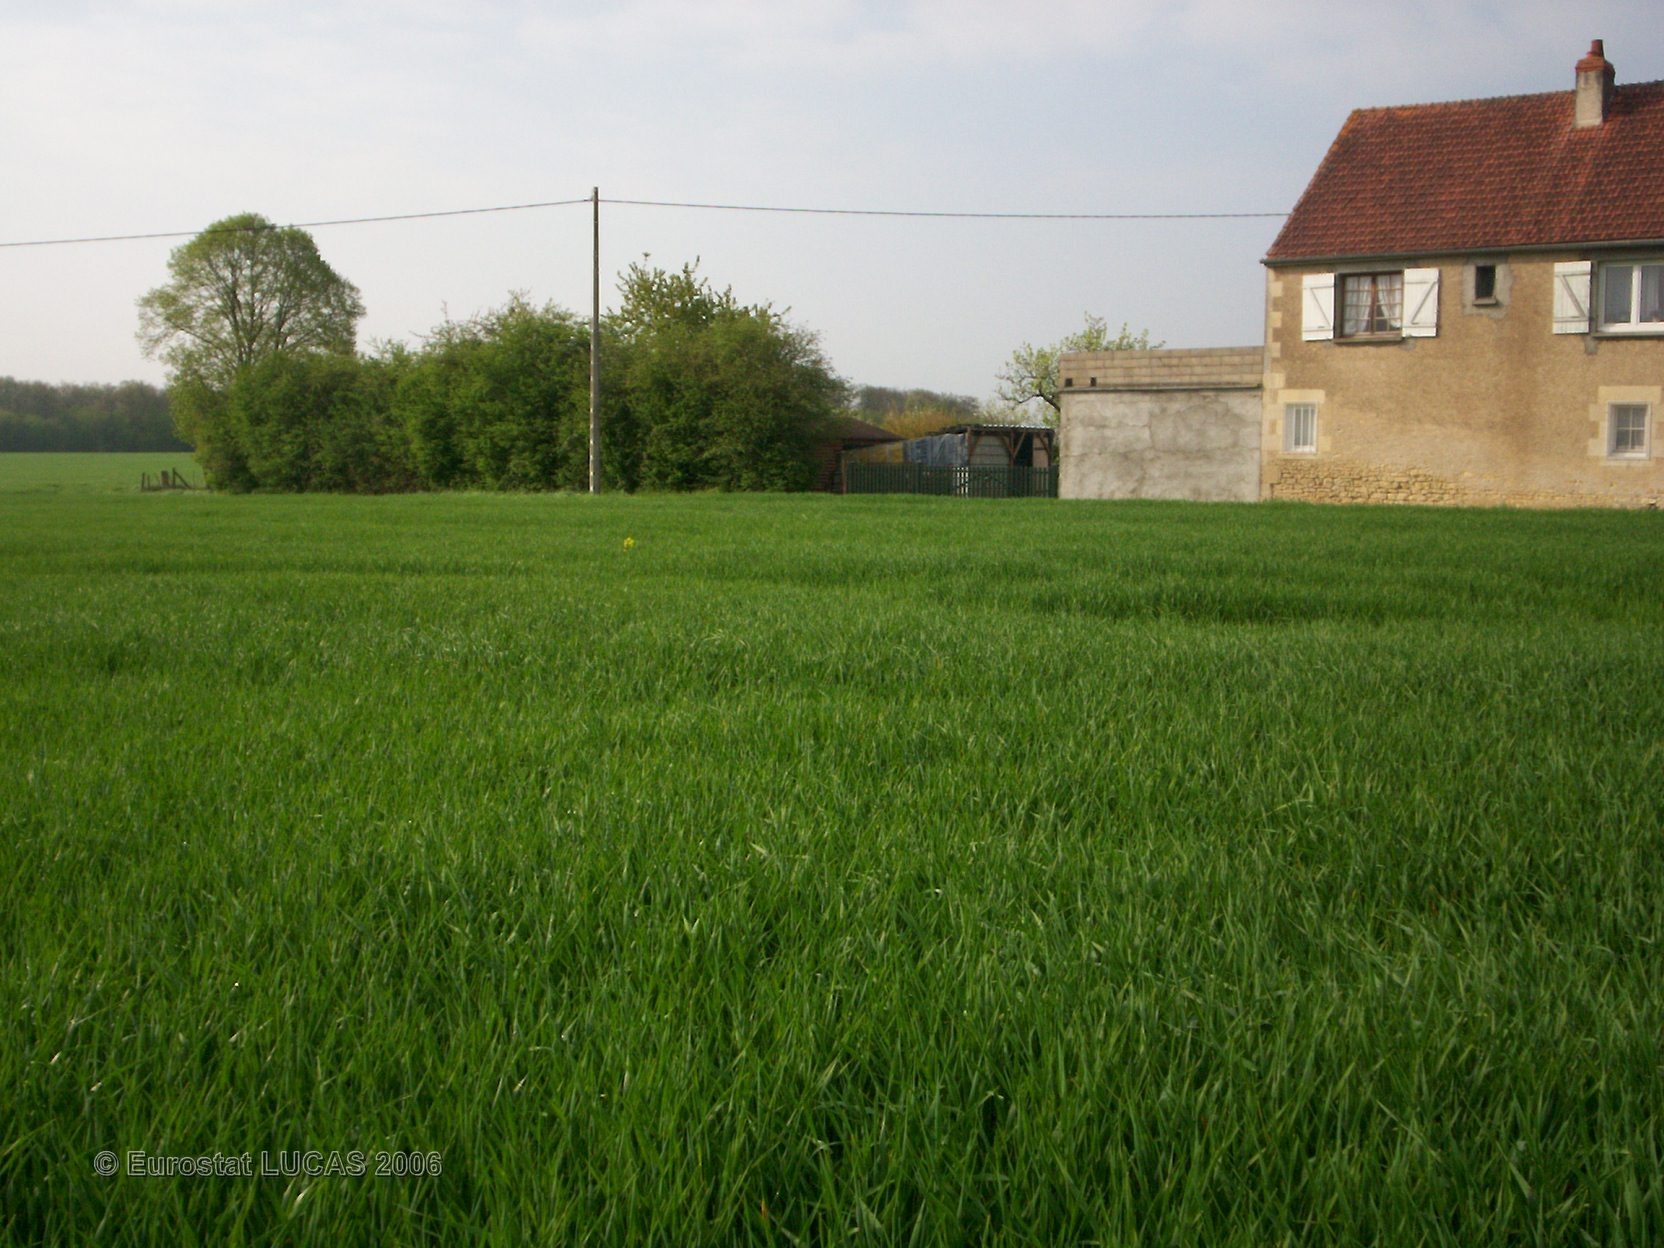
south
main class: Cropland
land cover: Barley
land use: Agriculture (excluding fallow land and kitchen gardens)
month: April
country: FR
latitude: 47.2298
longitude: 3.0877
